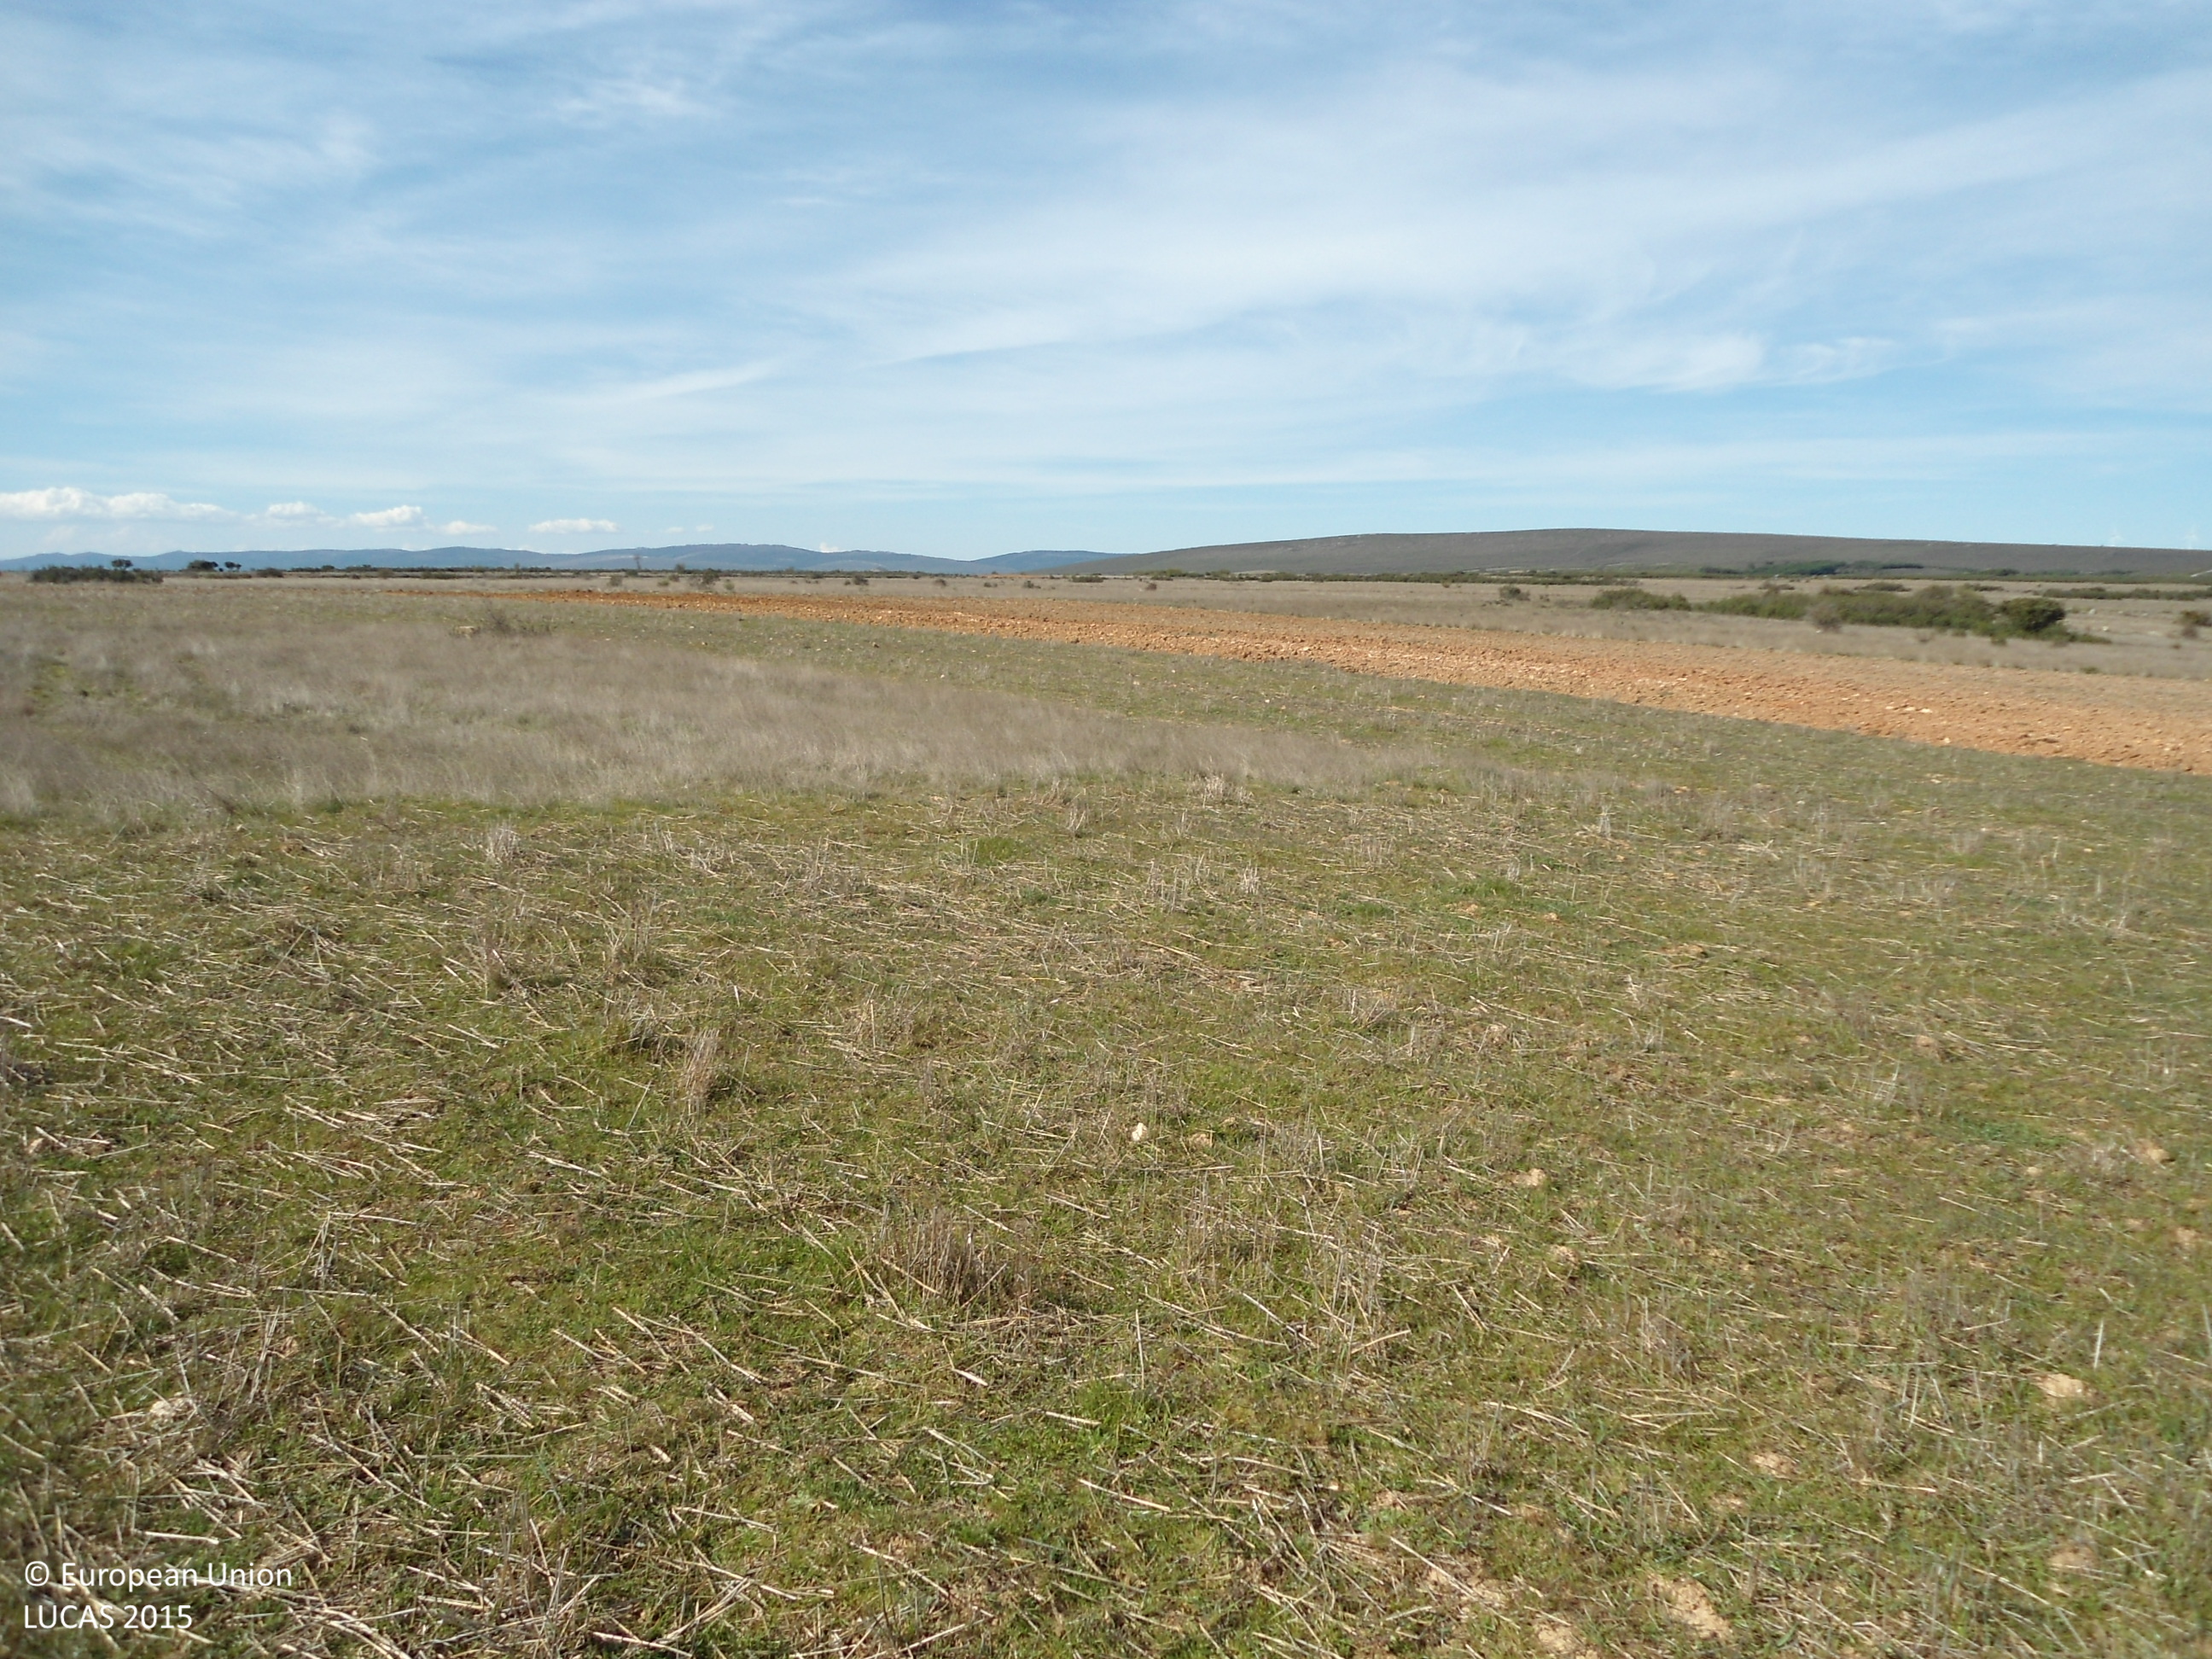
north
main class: Grassland
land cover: Spontaneously vegetated surfaces
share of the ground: > 75 %
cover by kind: herbaceous plants 100 %
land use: Agriculture (excluding fallow land and kitchen gardens)
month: April
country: ES
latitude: 41.7518
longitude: -6.1535
